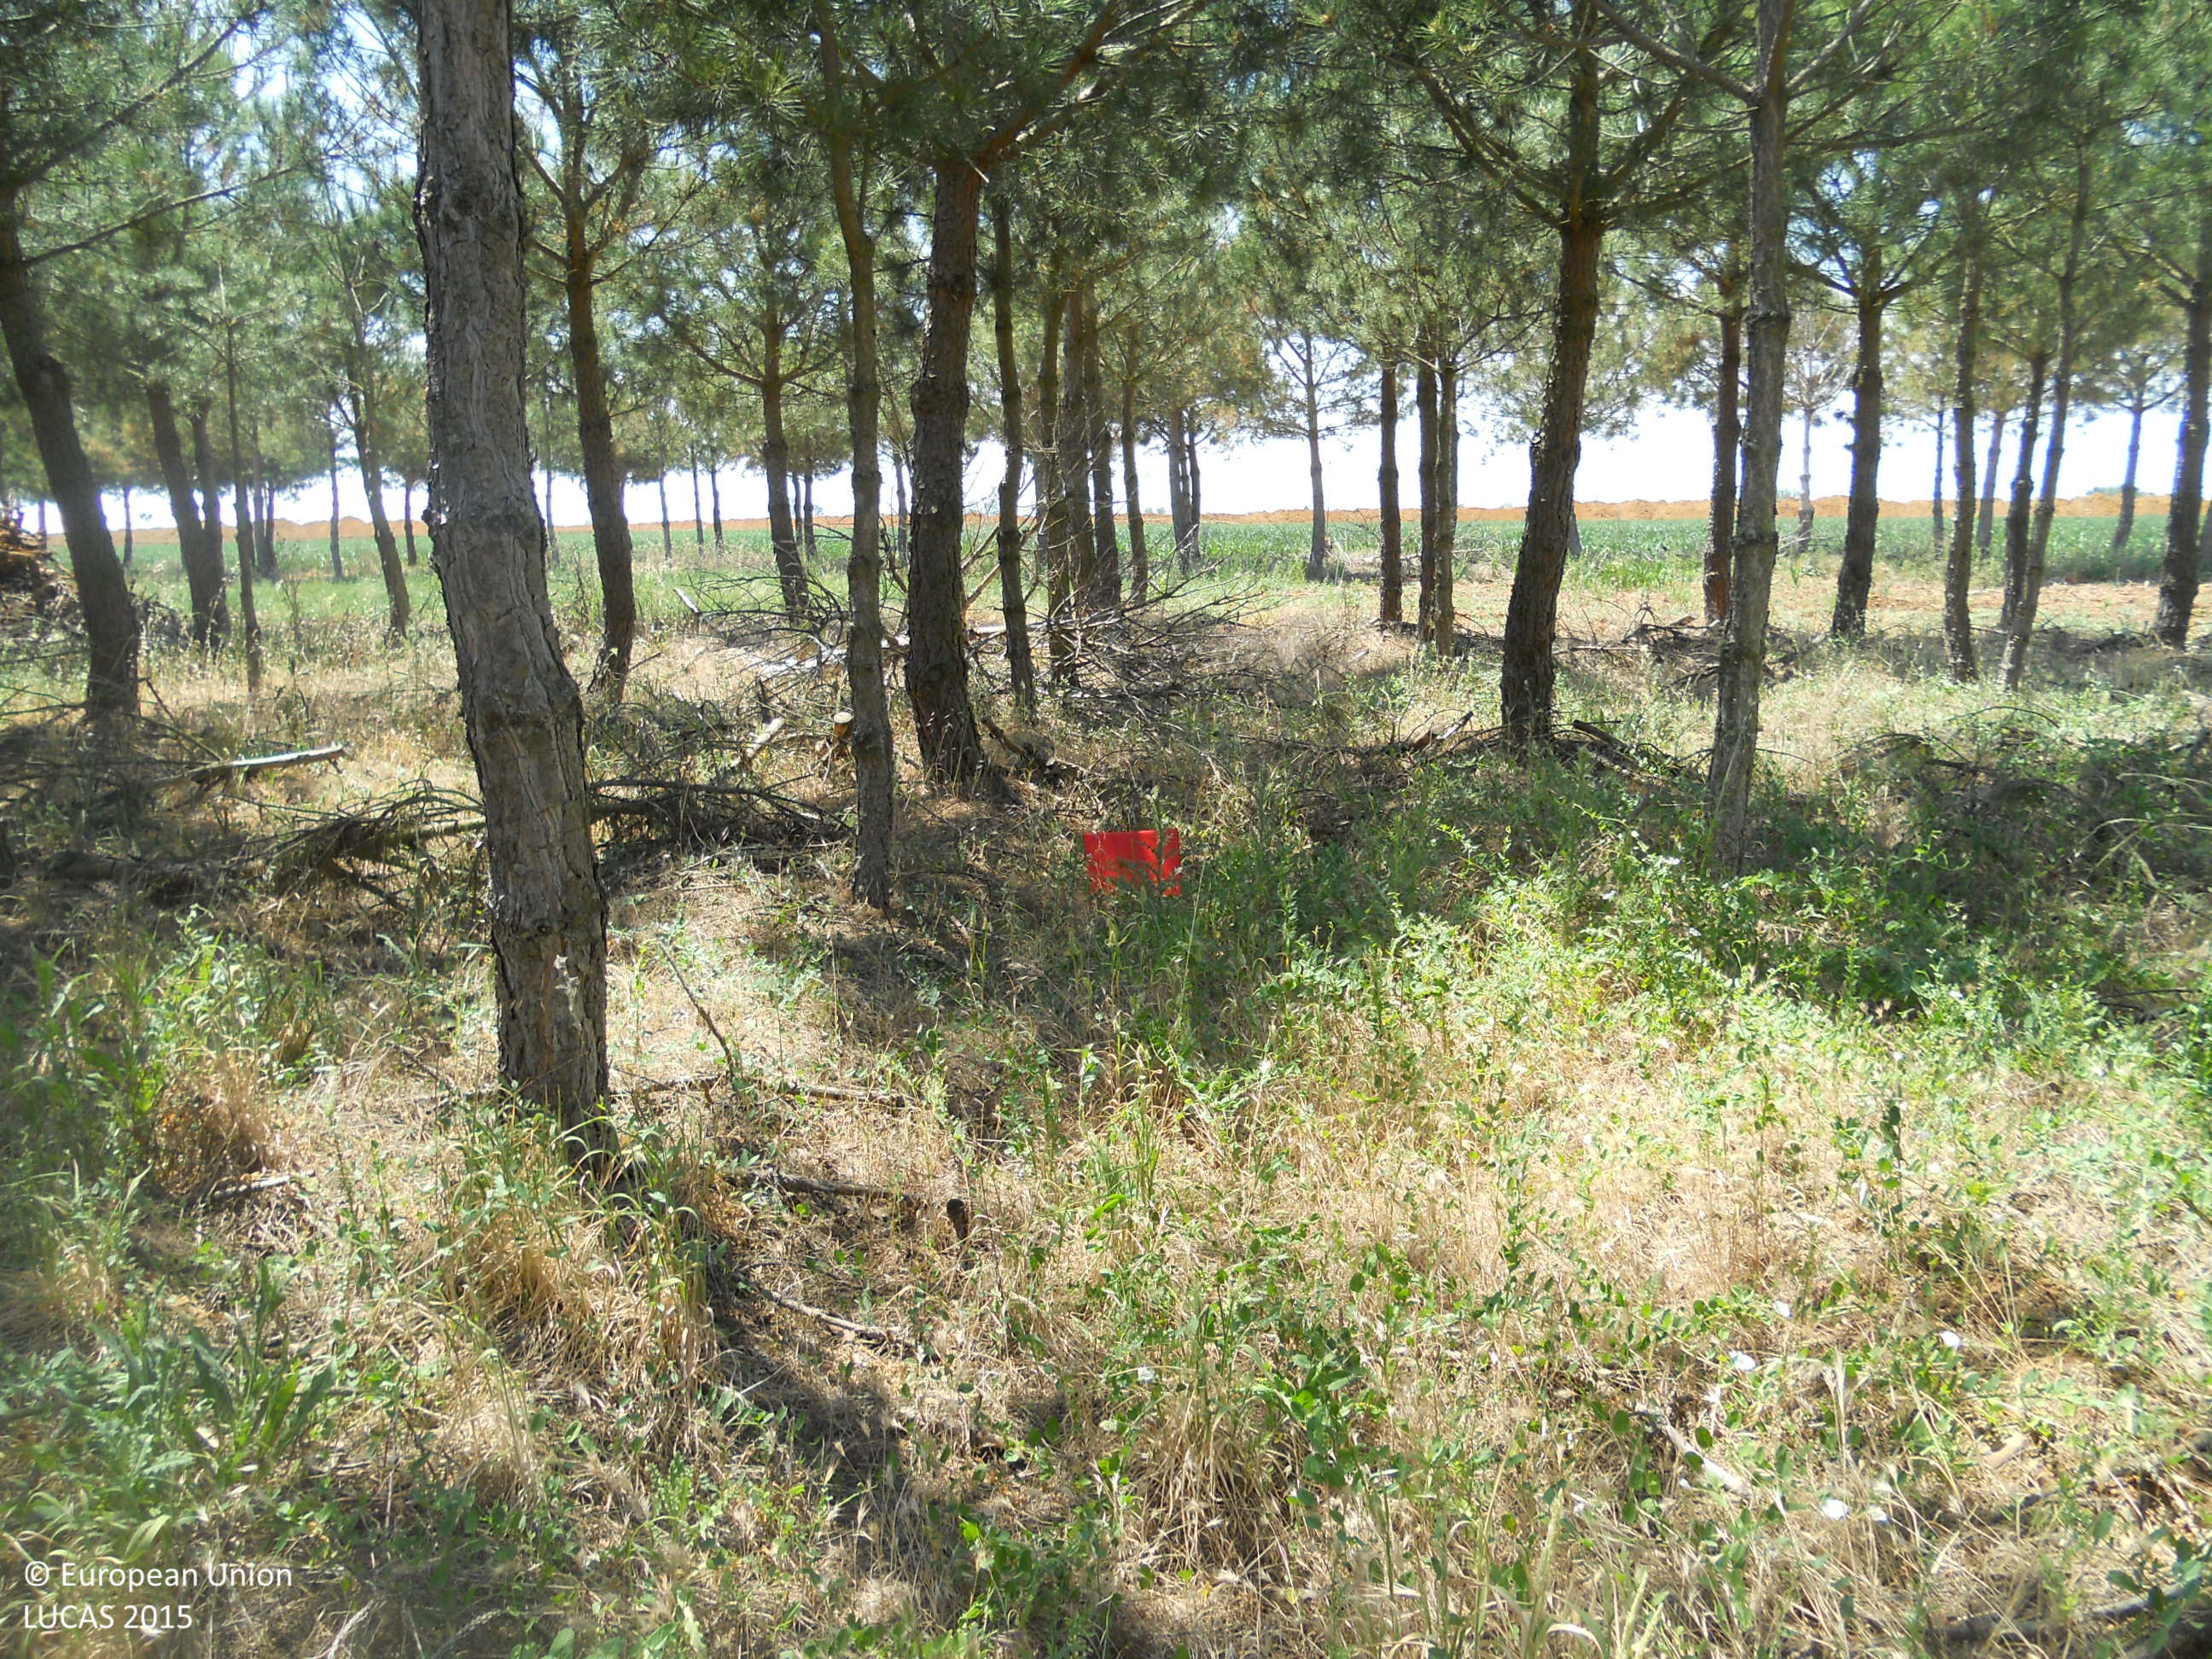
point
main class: Woodland
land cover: Pine dominated coniferous woodland
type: coniferous forest of the mediterranean region
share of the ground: > 75 %
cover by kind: coniferous forest trees 80 %, herbaceous plants 20 %
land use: Forestry
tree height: < 5 m
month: June
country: ES
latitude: 42.3084
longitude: -5.6602
